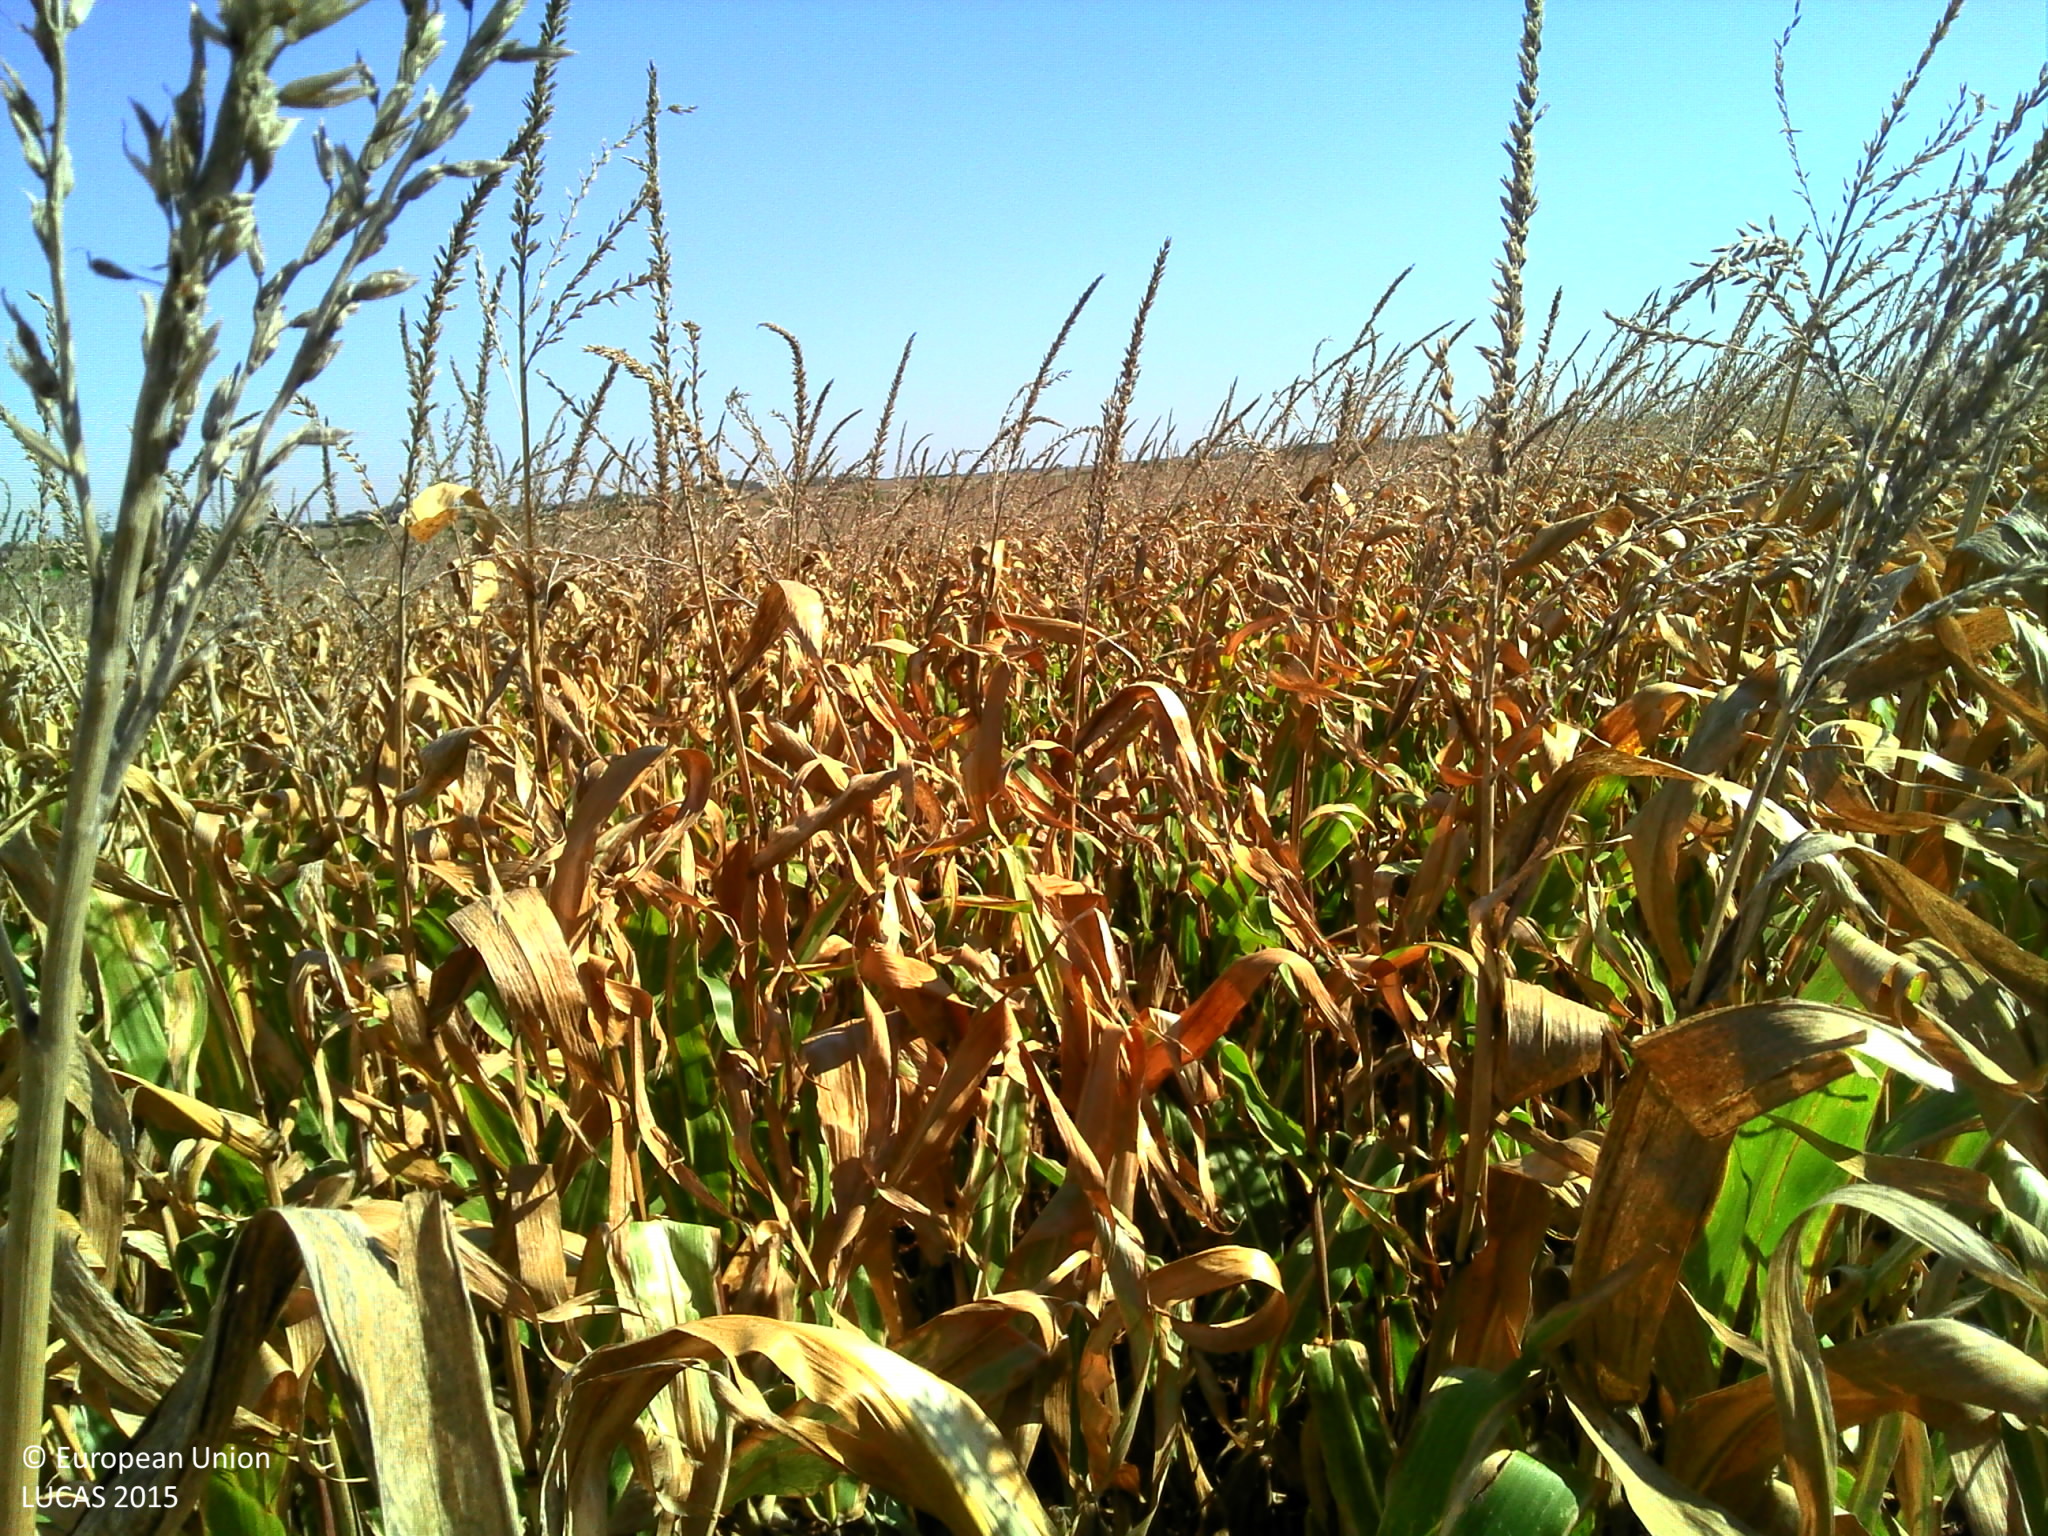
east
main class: Cropland
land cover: Maize
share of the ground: > 75 %
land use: Agriculture (excluding fallow land and kitchen gardens)
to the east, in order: Maize; Ditches and canals; Grass margins; Paved roads, cycling and walking lanes; Grass margins; Abandoned hedges; Electric lines; Other fibre and oleaginous crops
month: September
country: FR
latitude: 46.4963
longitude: -1.1212
